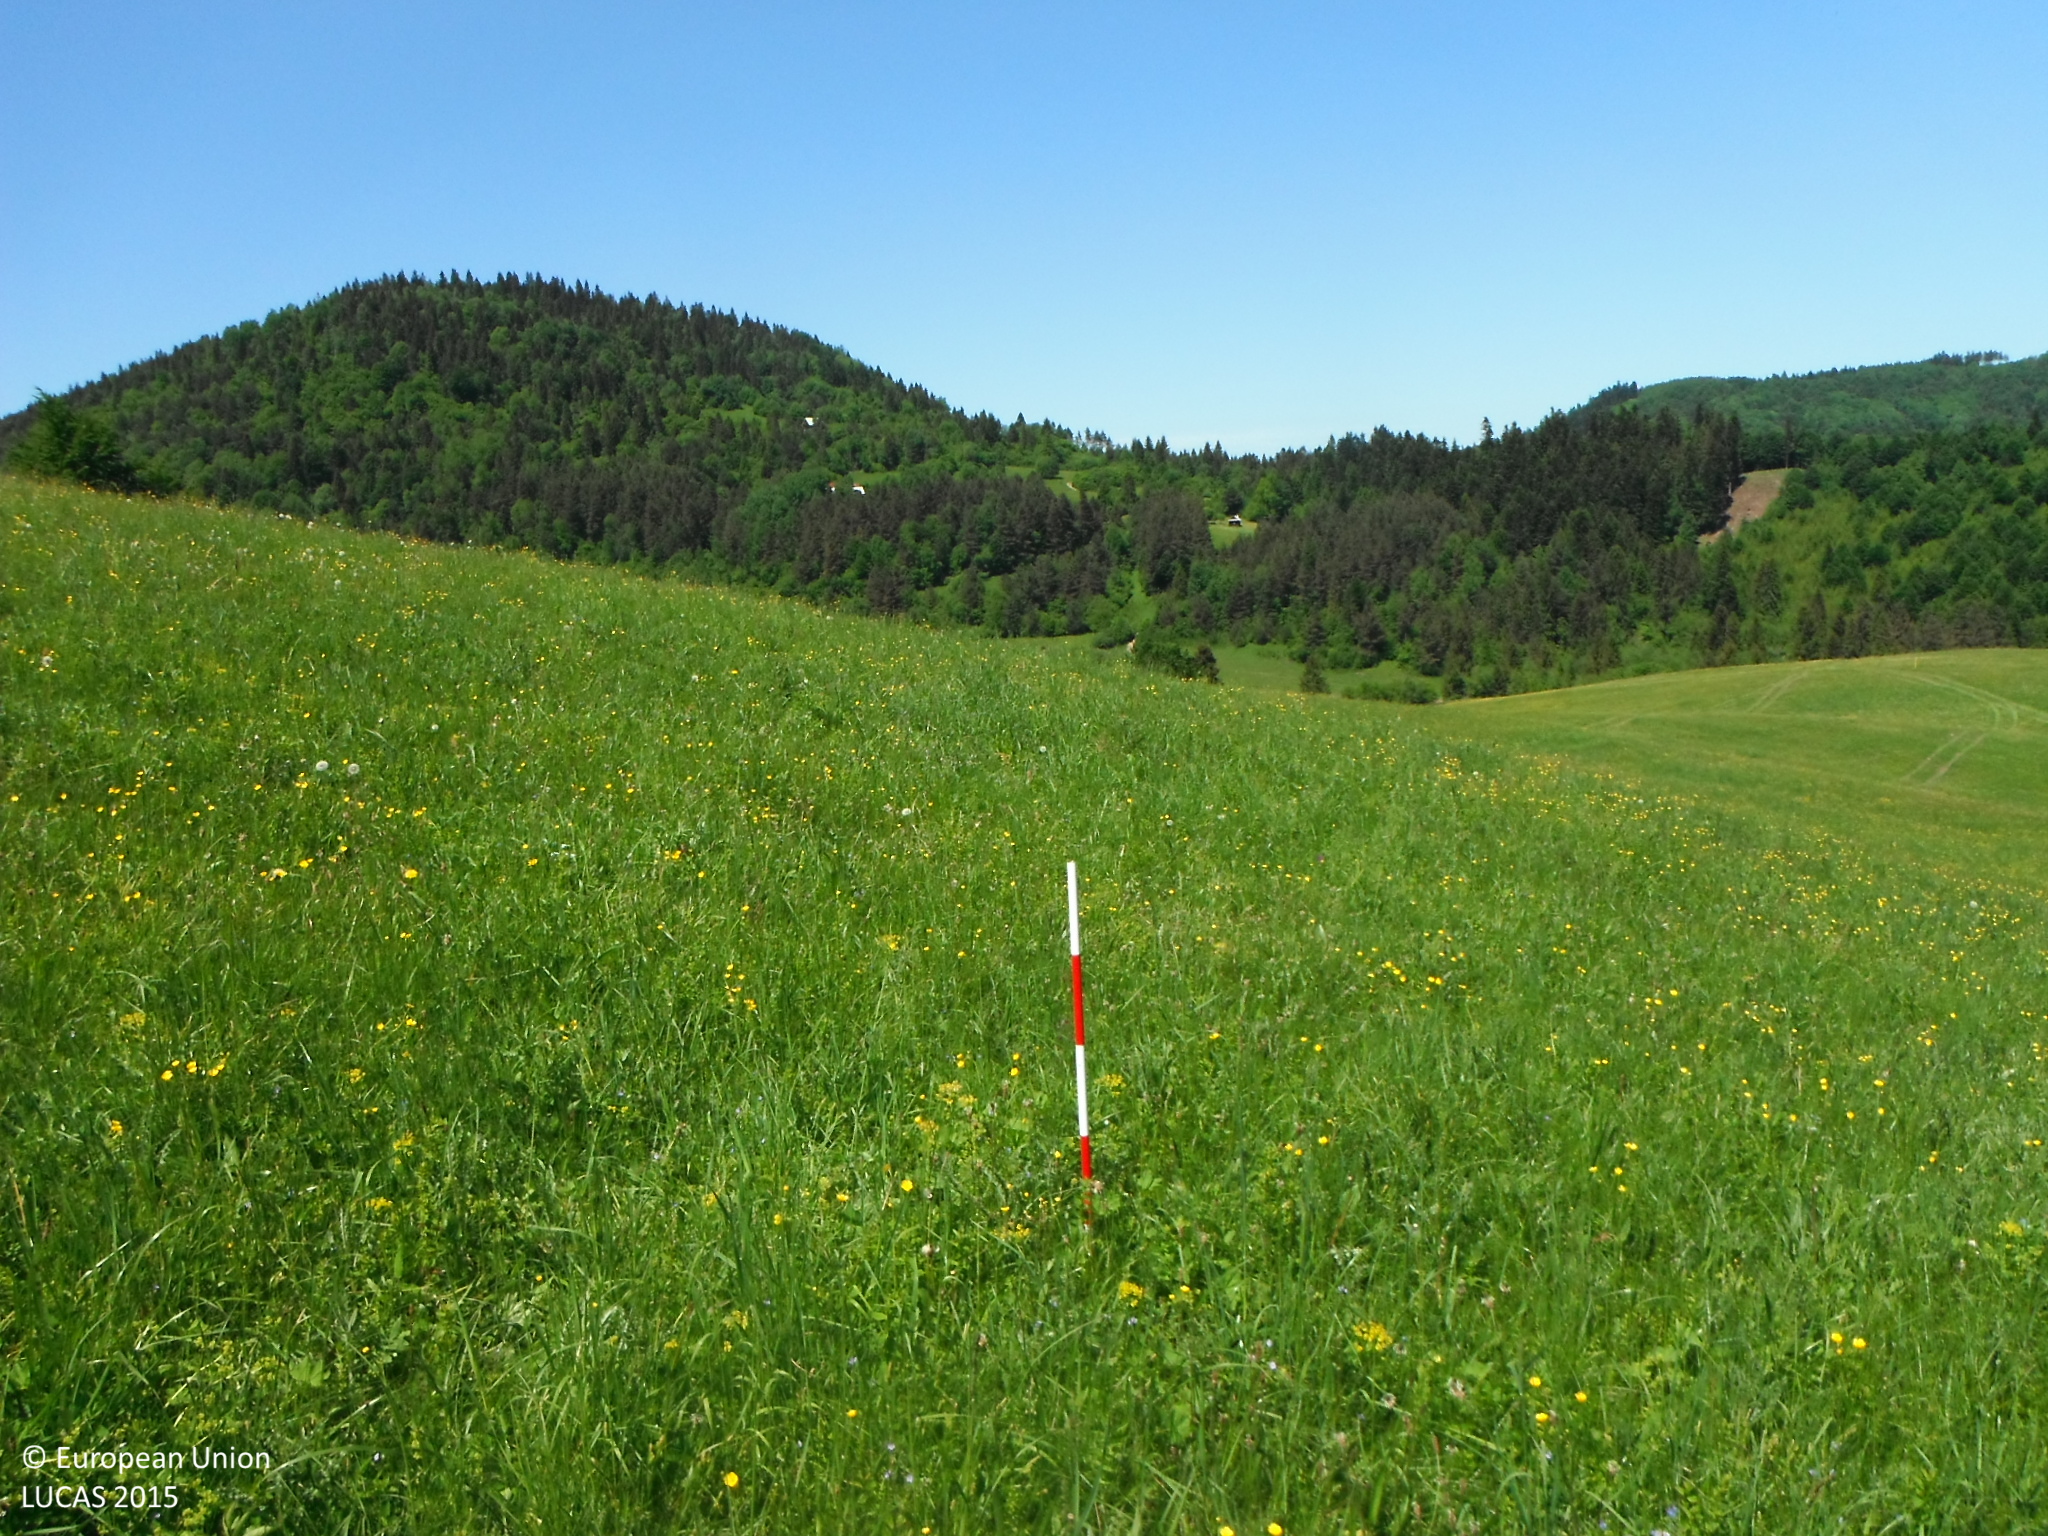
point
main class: Grassland
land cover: Grassland without tree/shrub cover
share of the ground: > 75 %
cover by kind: herbaceous plants 100 %
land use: Agriculture (excluding fallow land and kitchen gardens)
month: June
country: SK
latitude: 49.2400
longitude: 20.7389
